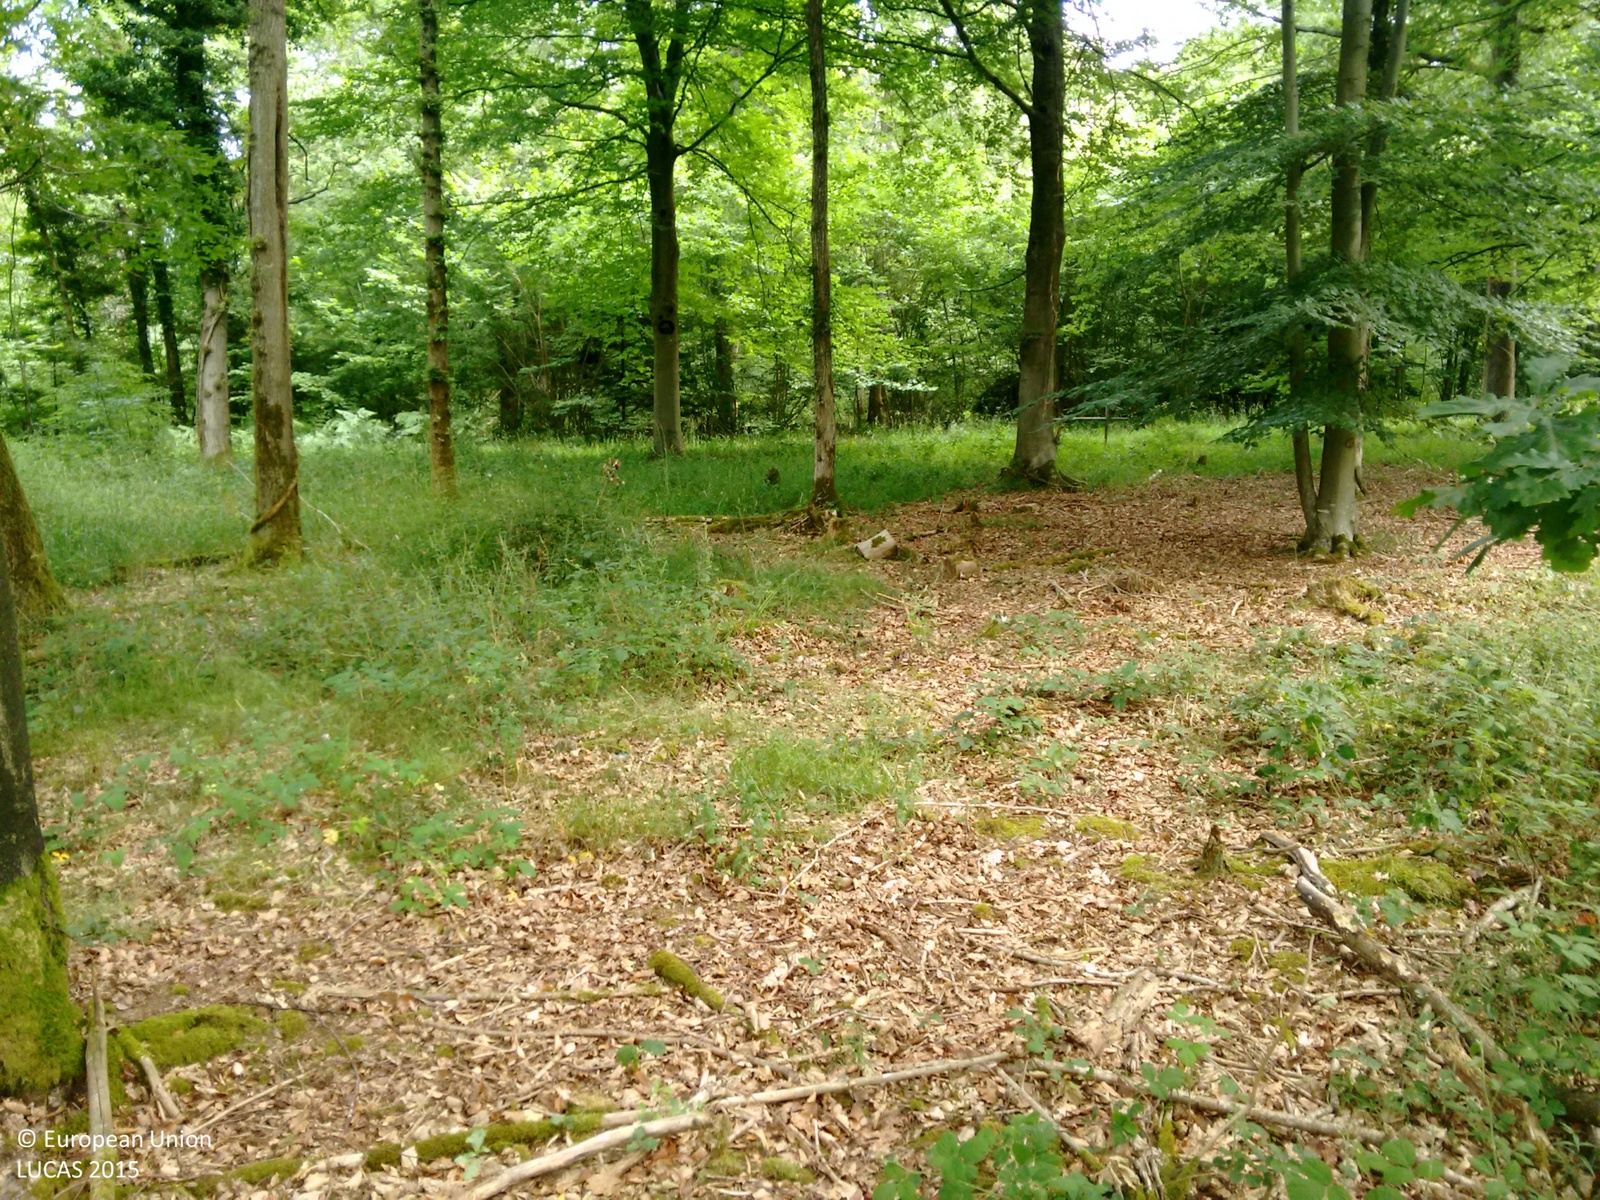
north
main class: Woodland
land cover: Broadleaved woodland
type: acidophilous oak and oak-birch forest
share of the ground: > 75 %
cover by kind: broadleaved forest trees 100 %
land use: Forestry
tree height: > 5 m
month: July
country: GB
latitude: 51.0685
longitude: -0.5854
